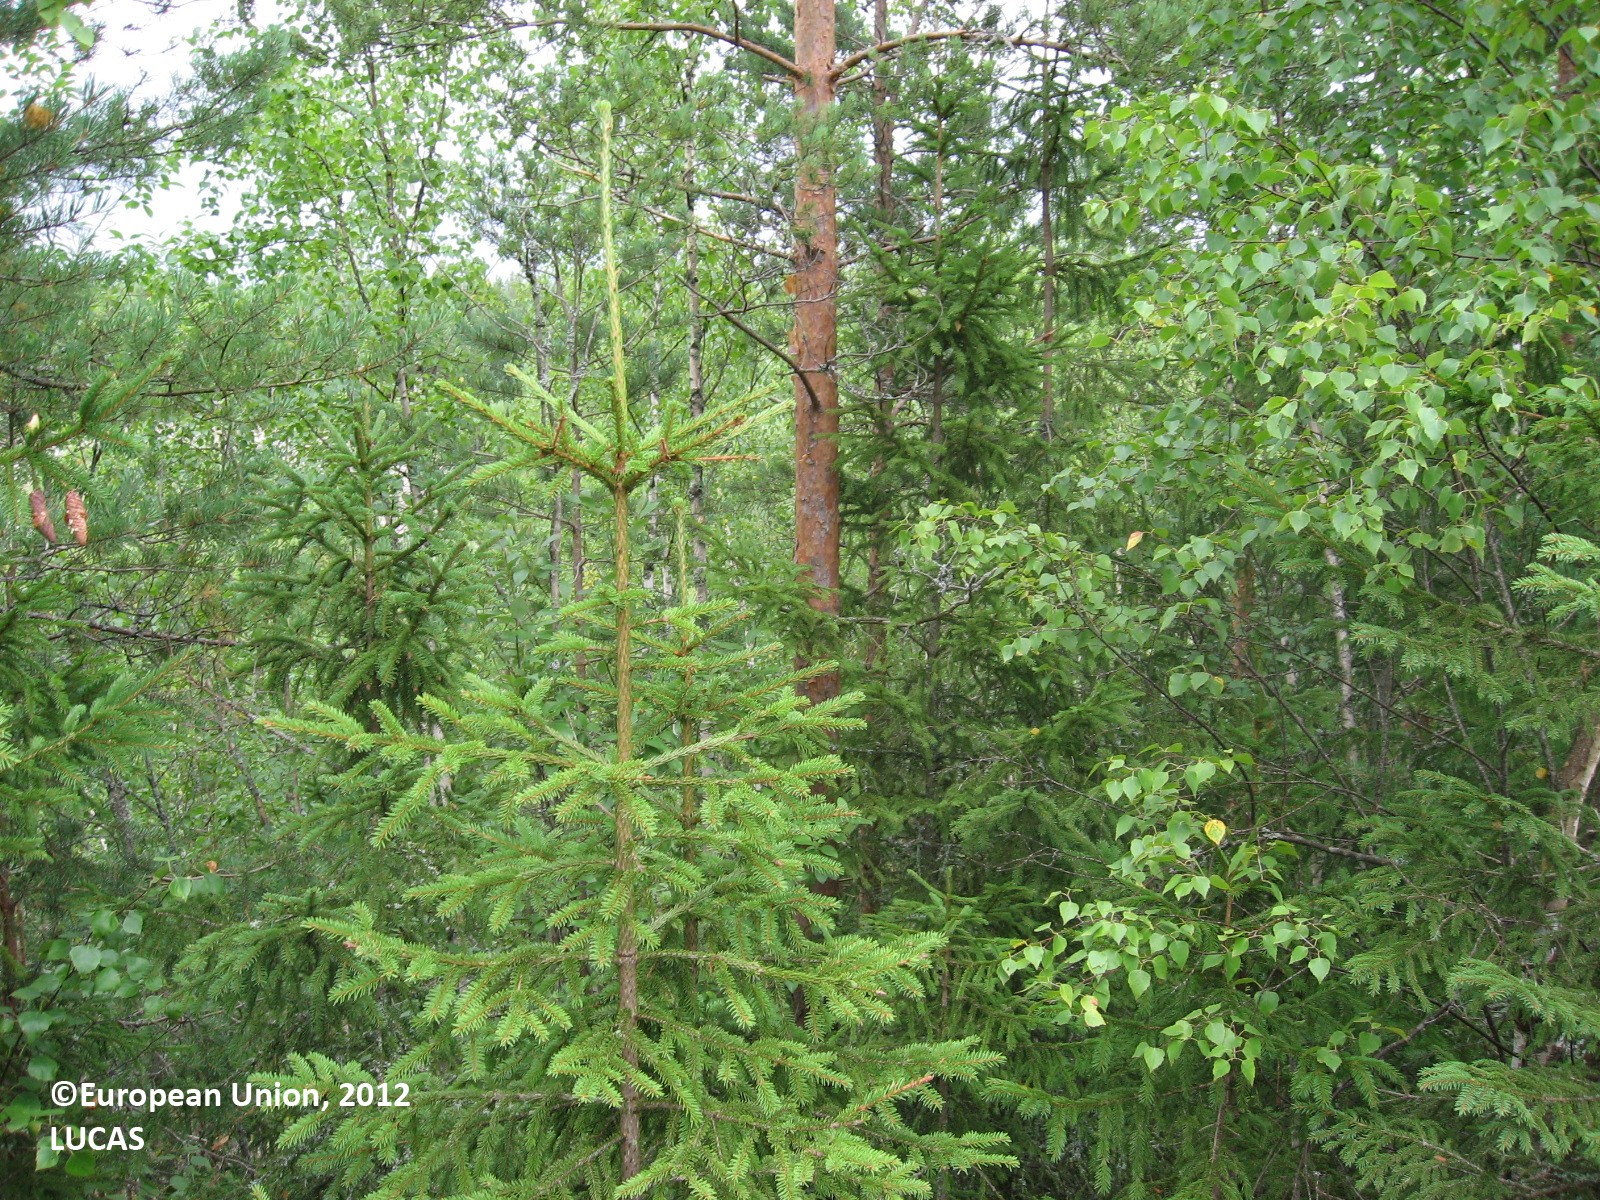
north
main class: Woodland
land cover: Spruce dominated mixed woodland
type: boreal forest
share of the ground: 50 - 75 %
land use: Forestry
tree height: < 5 m
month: August
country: FI
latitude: 60.5706
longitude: 25.4723
